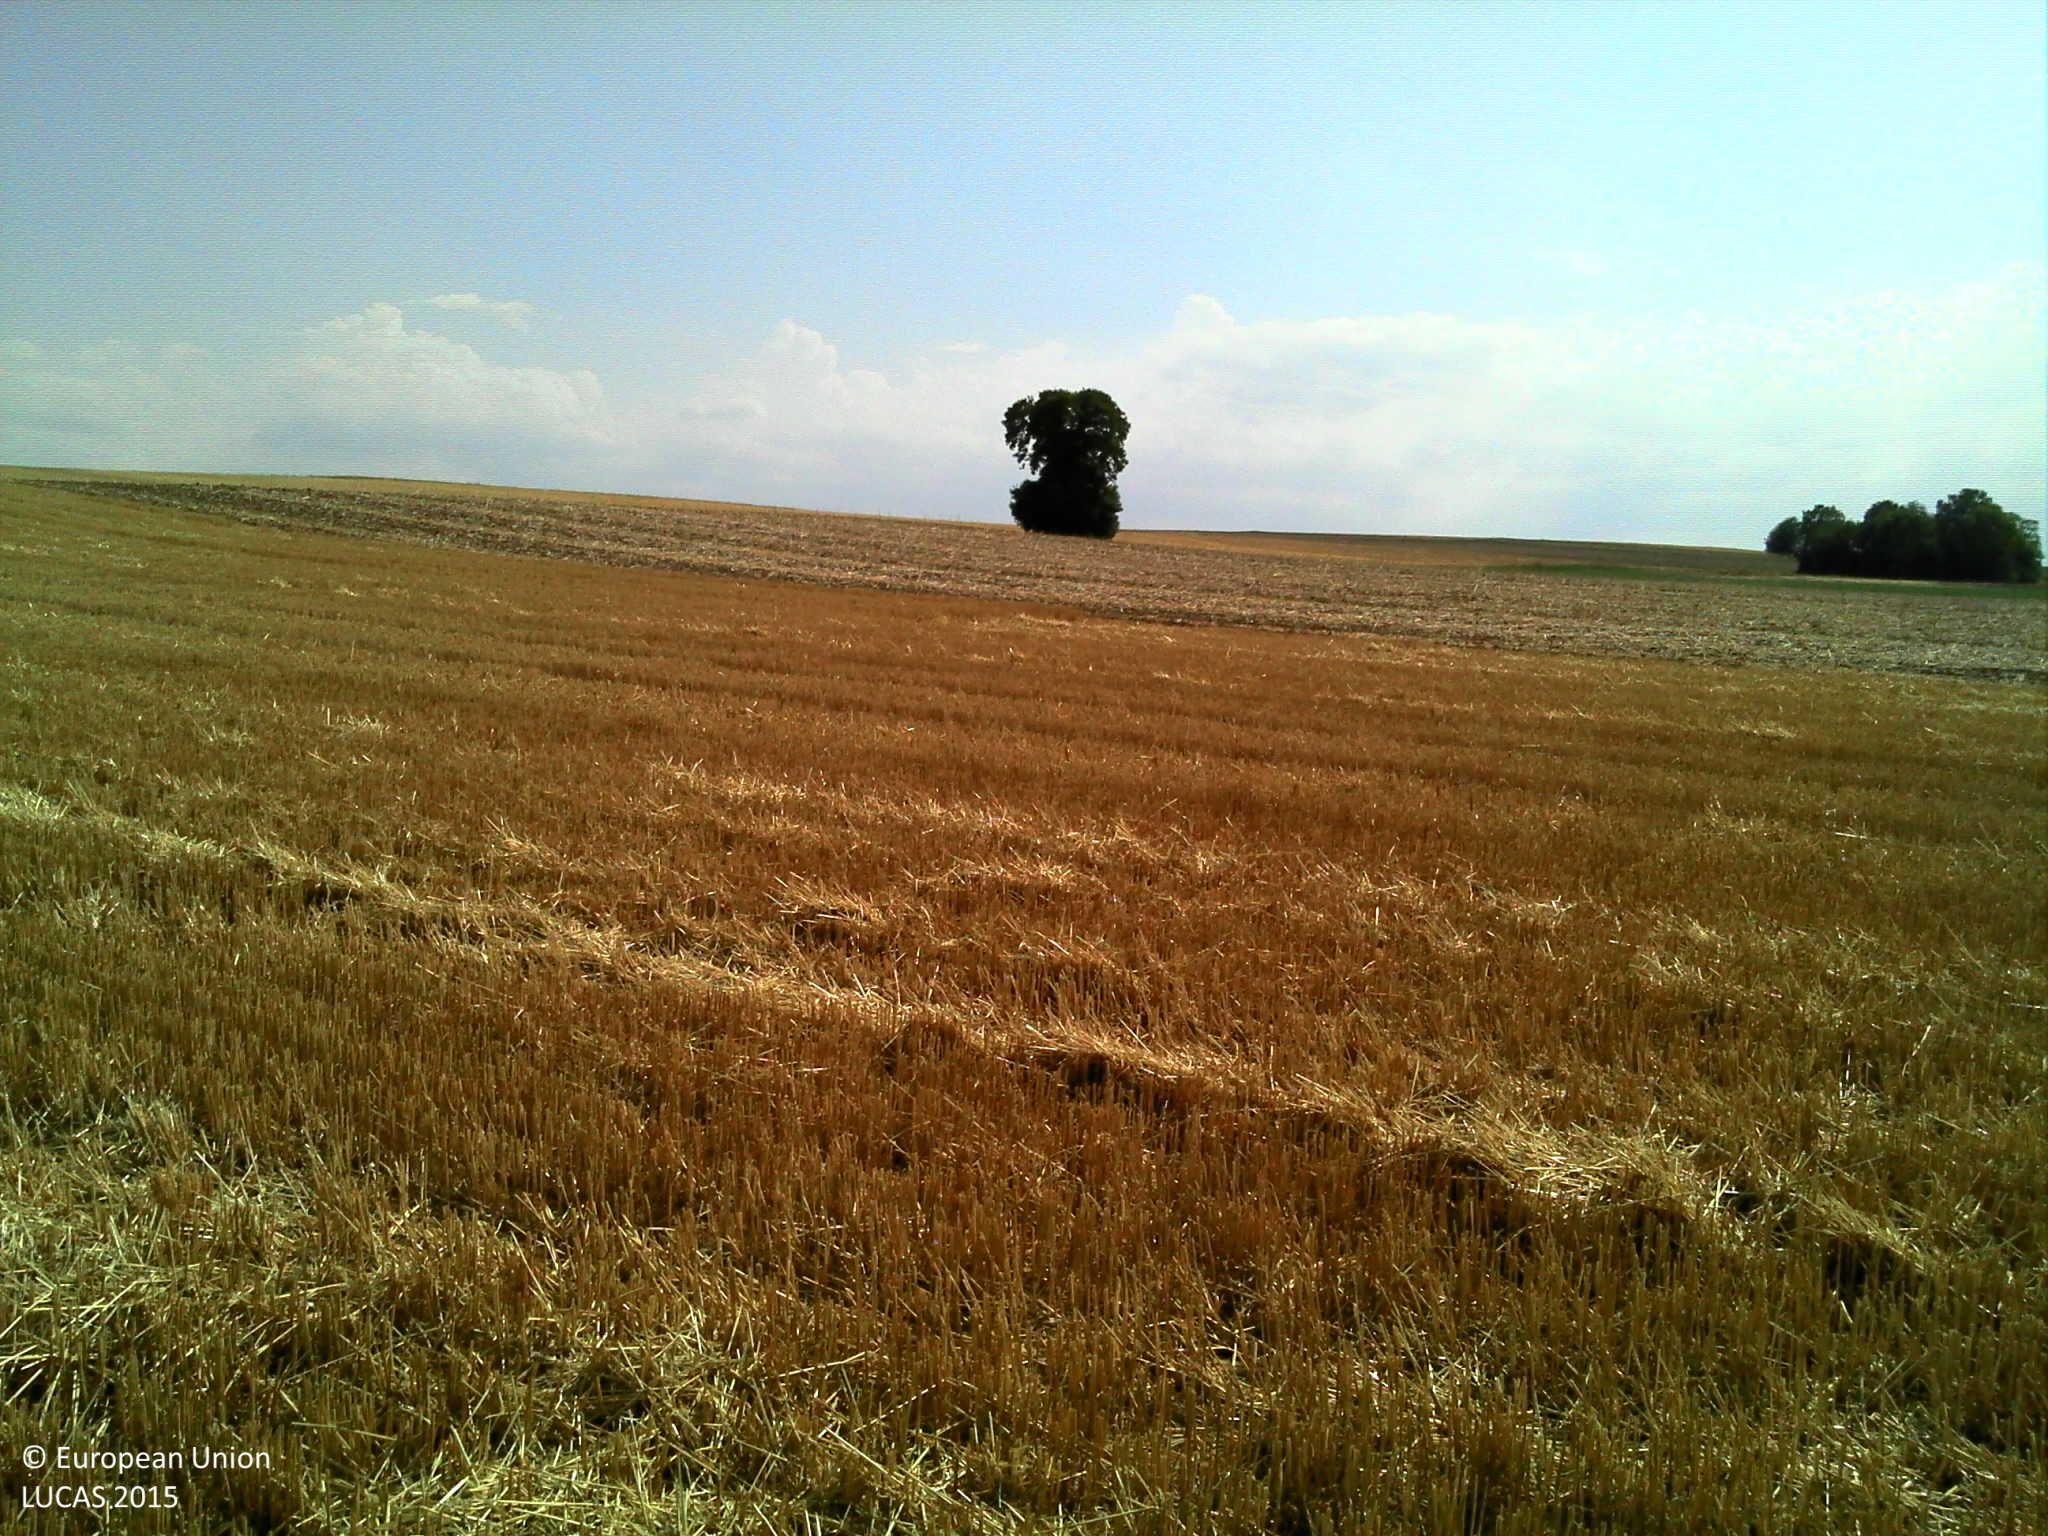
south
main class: Cropland
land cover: Common wheat
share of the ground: > 75 %
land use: Agriculture (excluding fallow land and kitchen gardens)
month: August
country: FR
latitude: 47.8472
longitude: 3.4337
